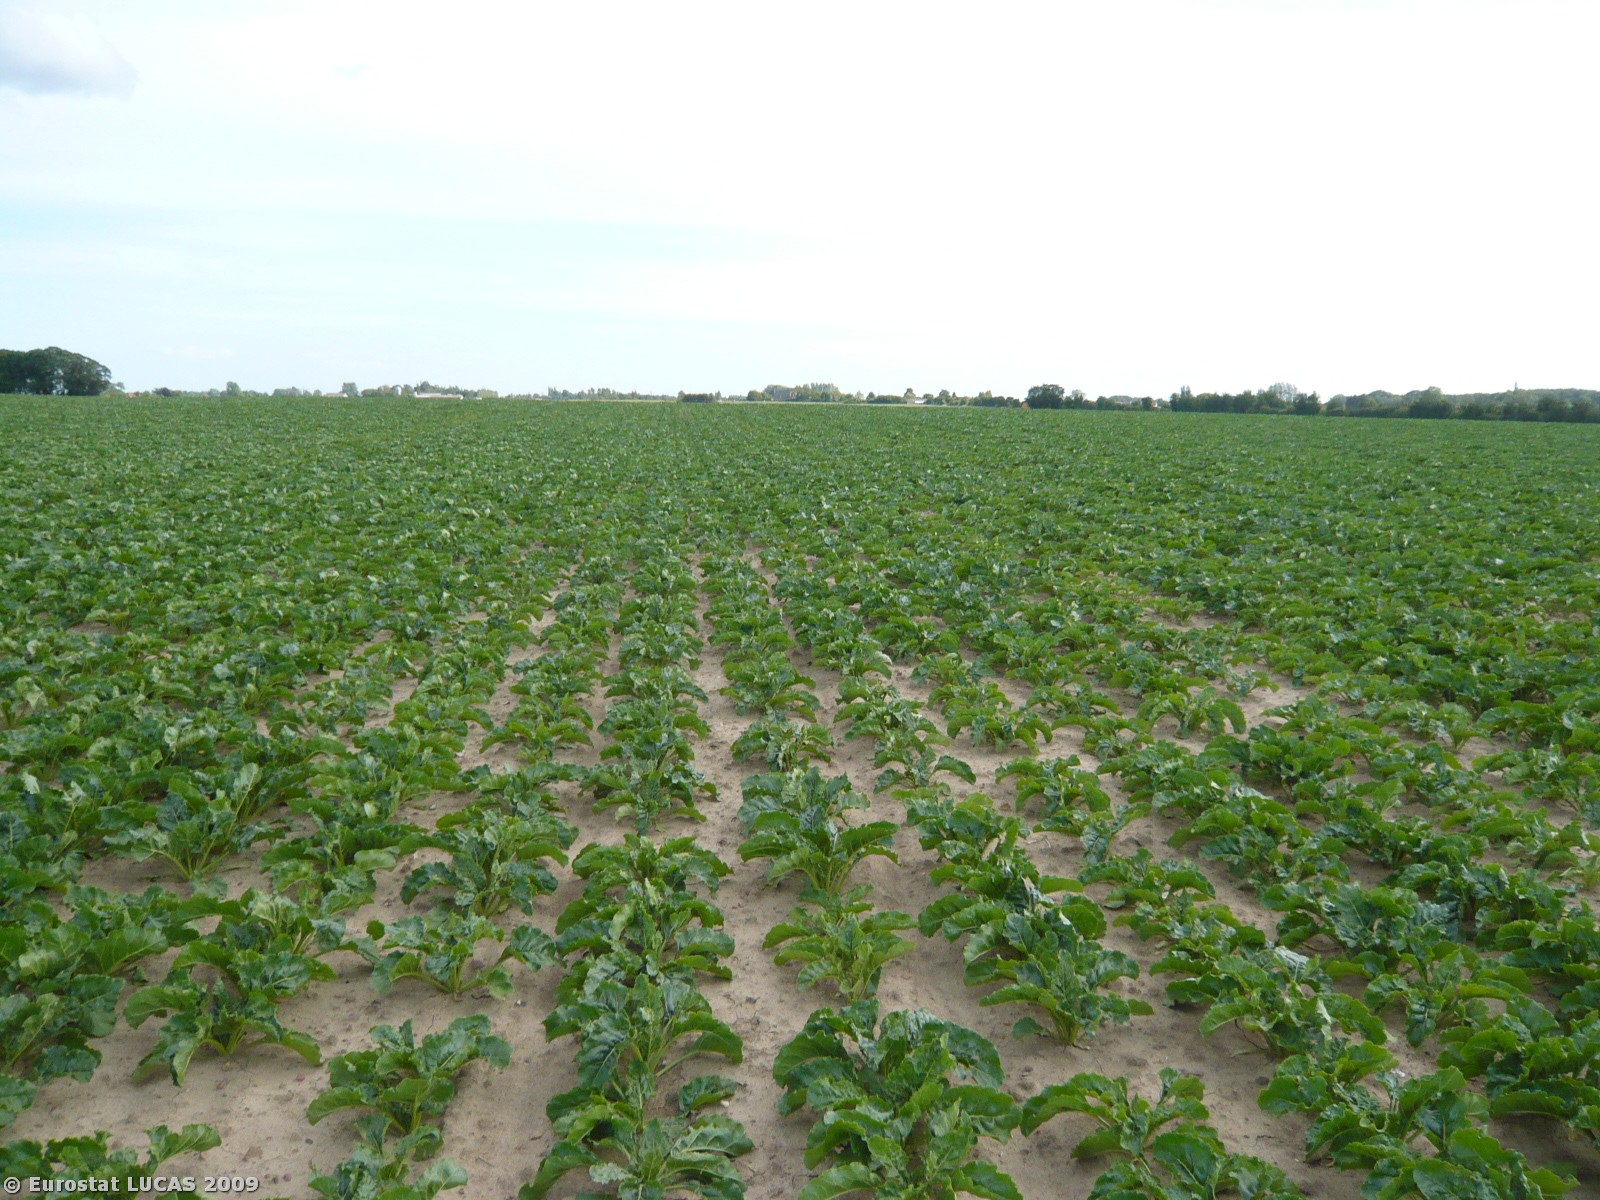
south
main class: Cropland
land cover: Sugar beet
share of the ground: > 75 %
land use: Agriculture (excluding fallow land and kitchen gardens)
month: June
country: DK
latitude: 54.7591
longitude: 11.4753
